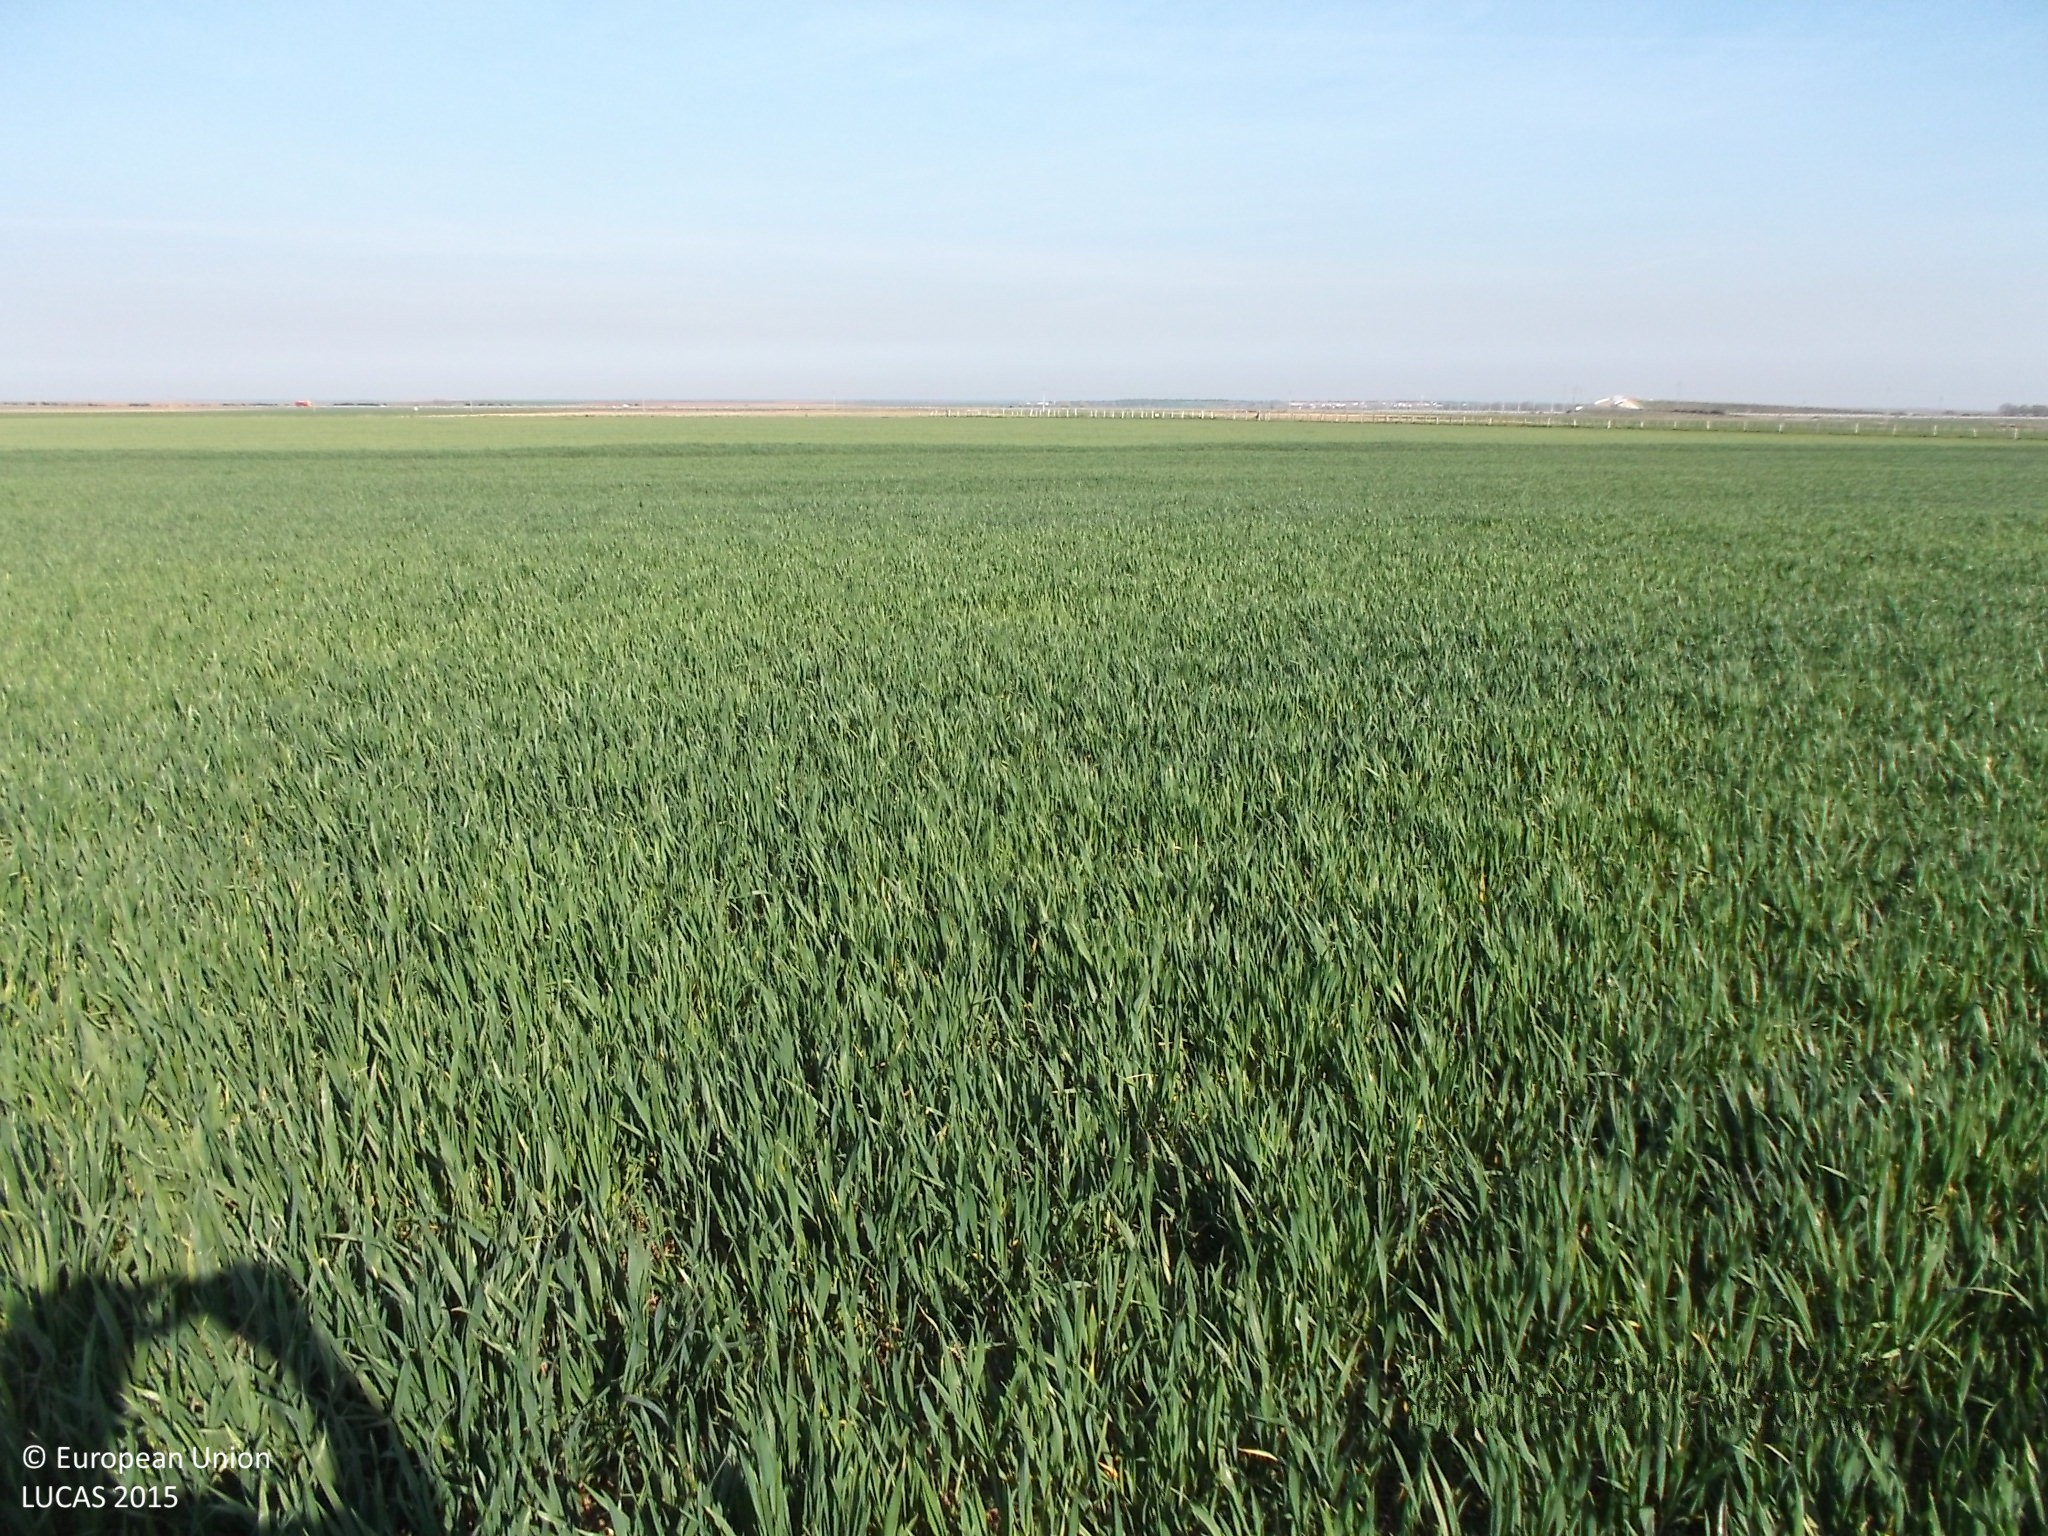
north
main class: Cropland
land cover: Common wheat
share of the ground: > 75 %
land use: Agriculture (excluding fallow land and kitchen gardens)
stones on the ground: 10 - 25 %
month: April
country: ES
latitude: 40.8921
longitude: -5.9025
